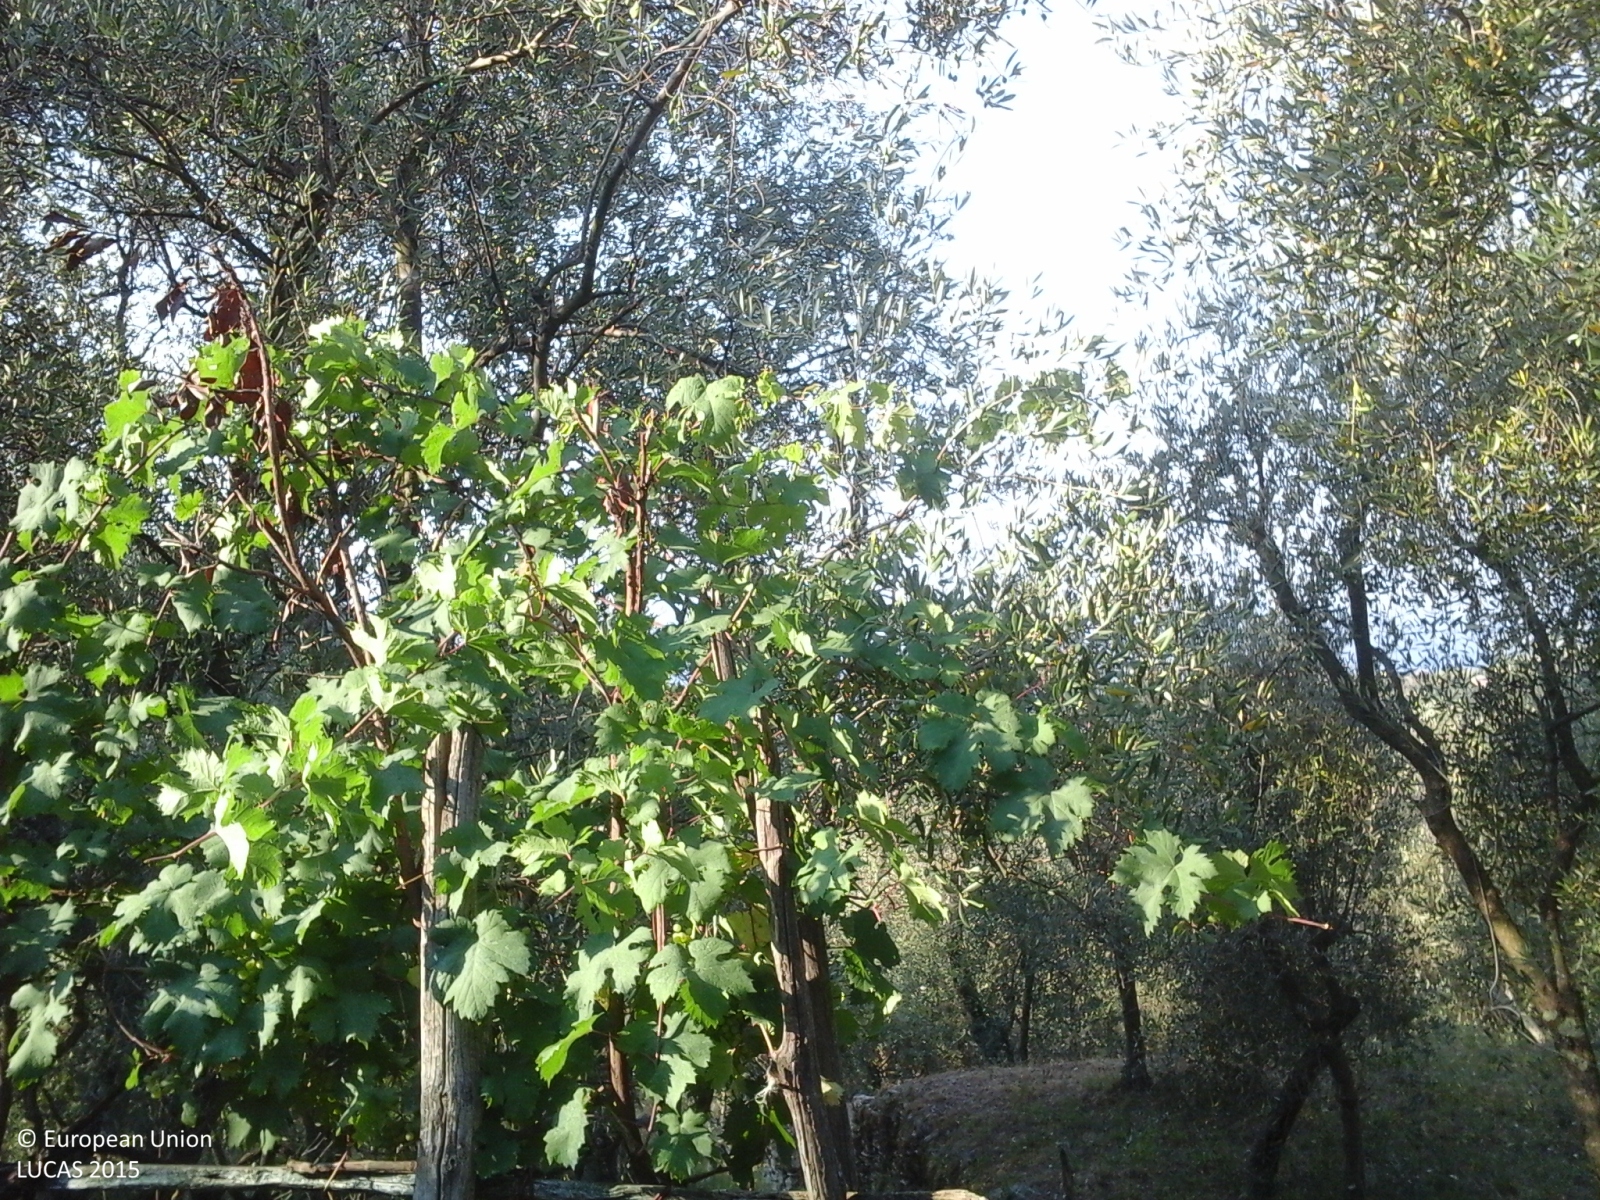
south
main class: Cropland
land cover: Olive groves
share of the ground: 50 - 75 %
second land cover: Grassland without tree/shrub cover
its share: 25 - 50 %
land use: Agriculture (excluding fallow land and kitchen gardens)
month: August
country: IT
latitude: 44.3127
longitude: 9.3871
